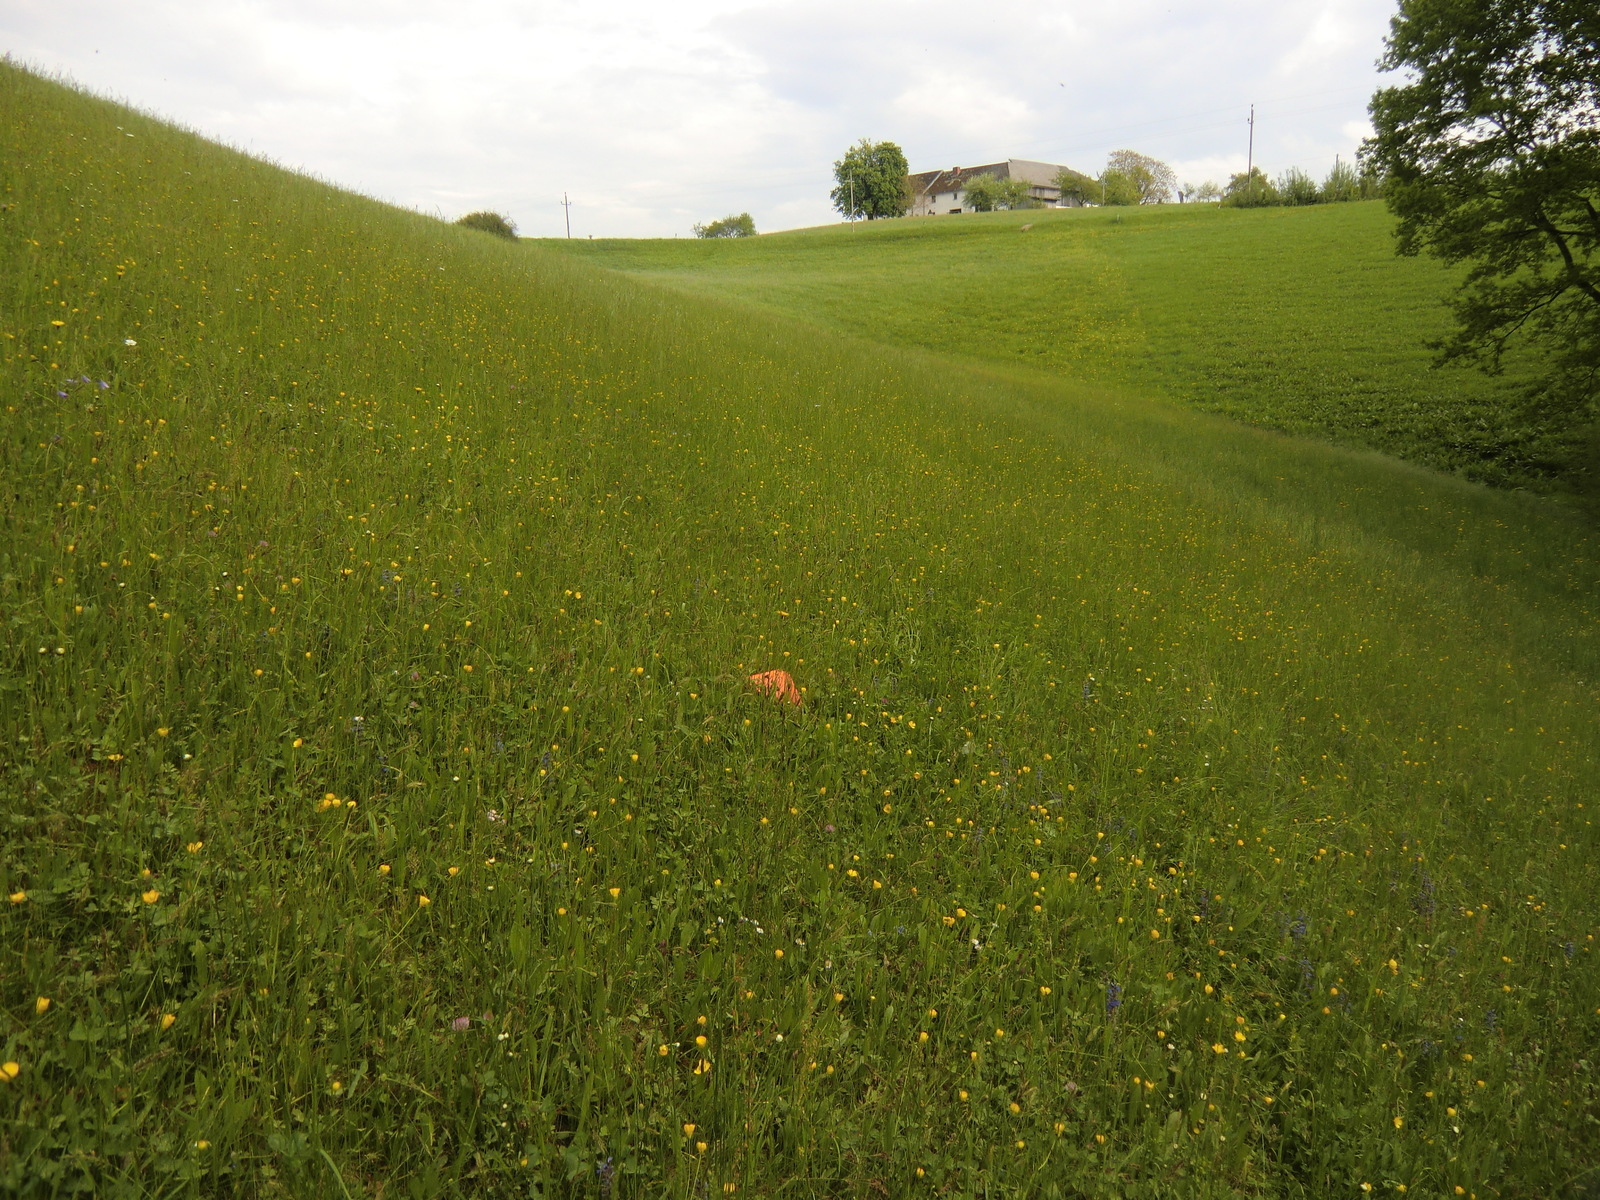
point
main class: Grassland
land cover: Grassland without tree/shrub cover
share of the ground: > 75 %
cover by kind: herbaceous plants 100 %
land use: Agriculture (excluding fallow land and kitchen gardens)
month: May
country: AT
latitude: 48.2808
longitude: 14.8118
